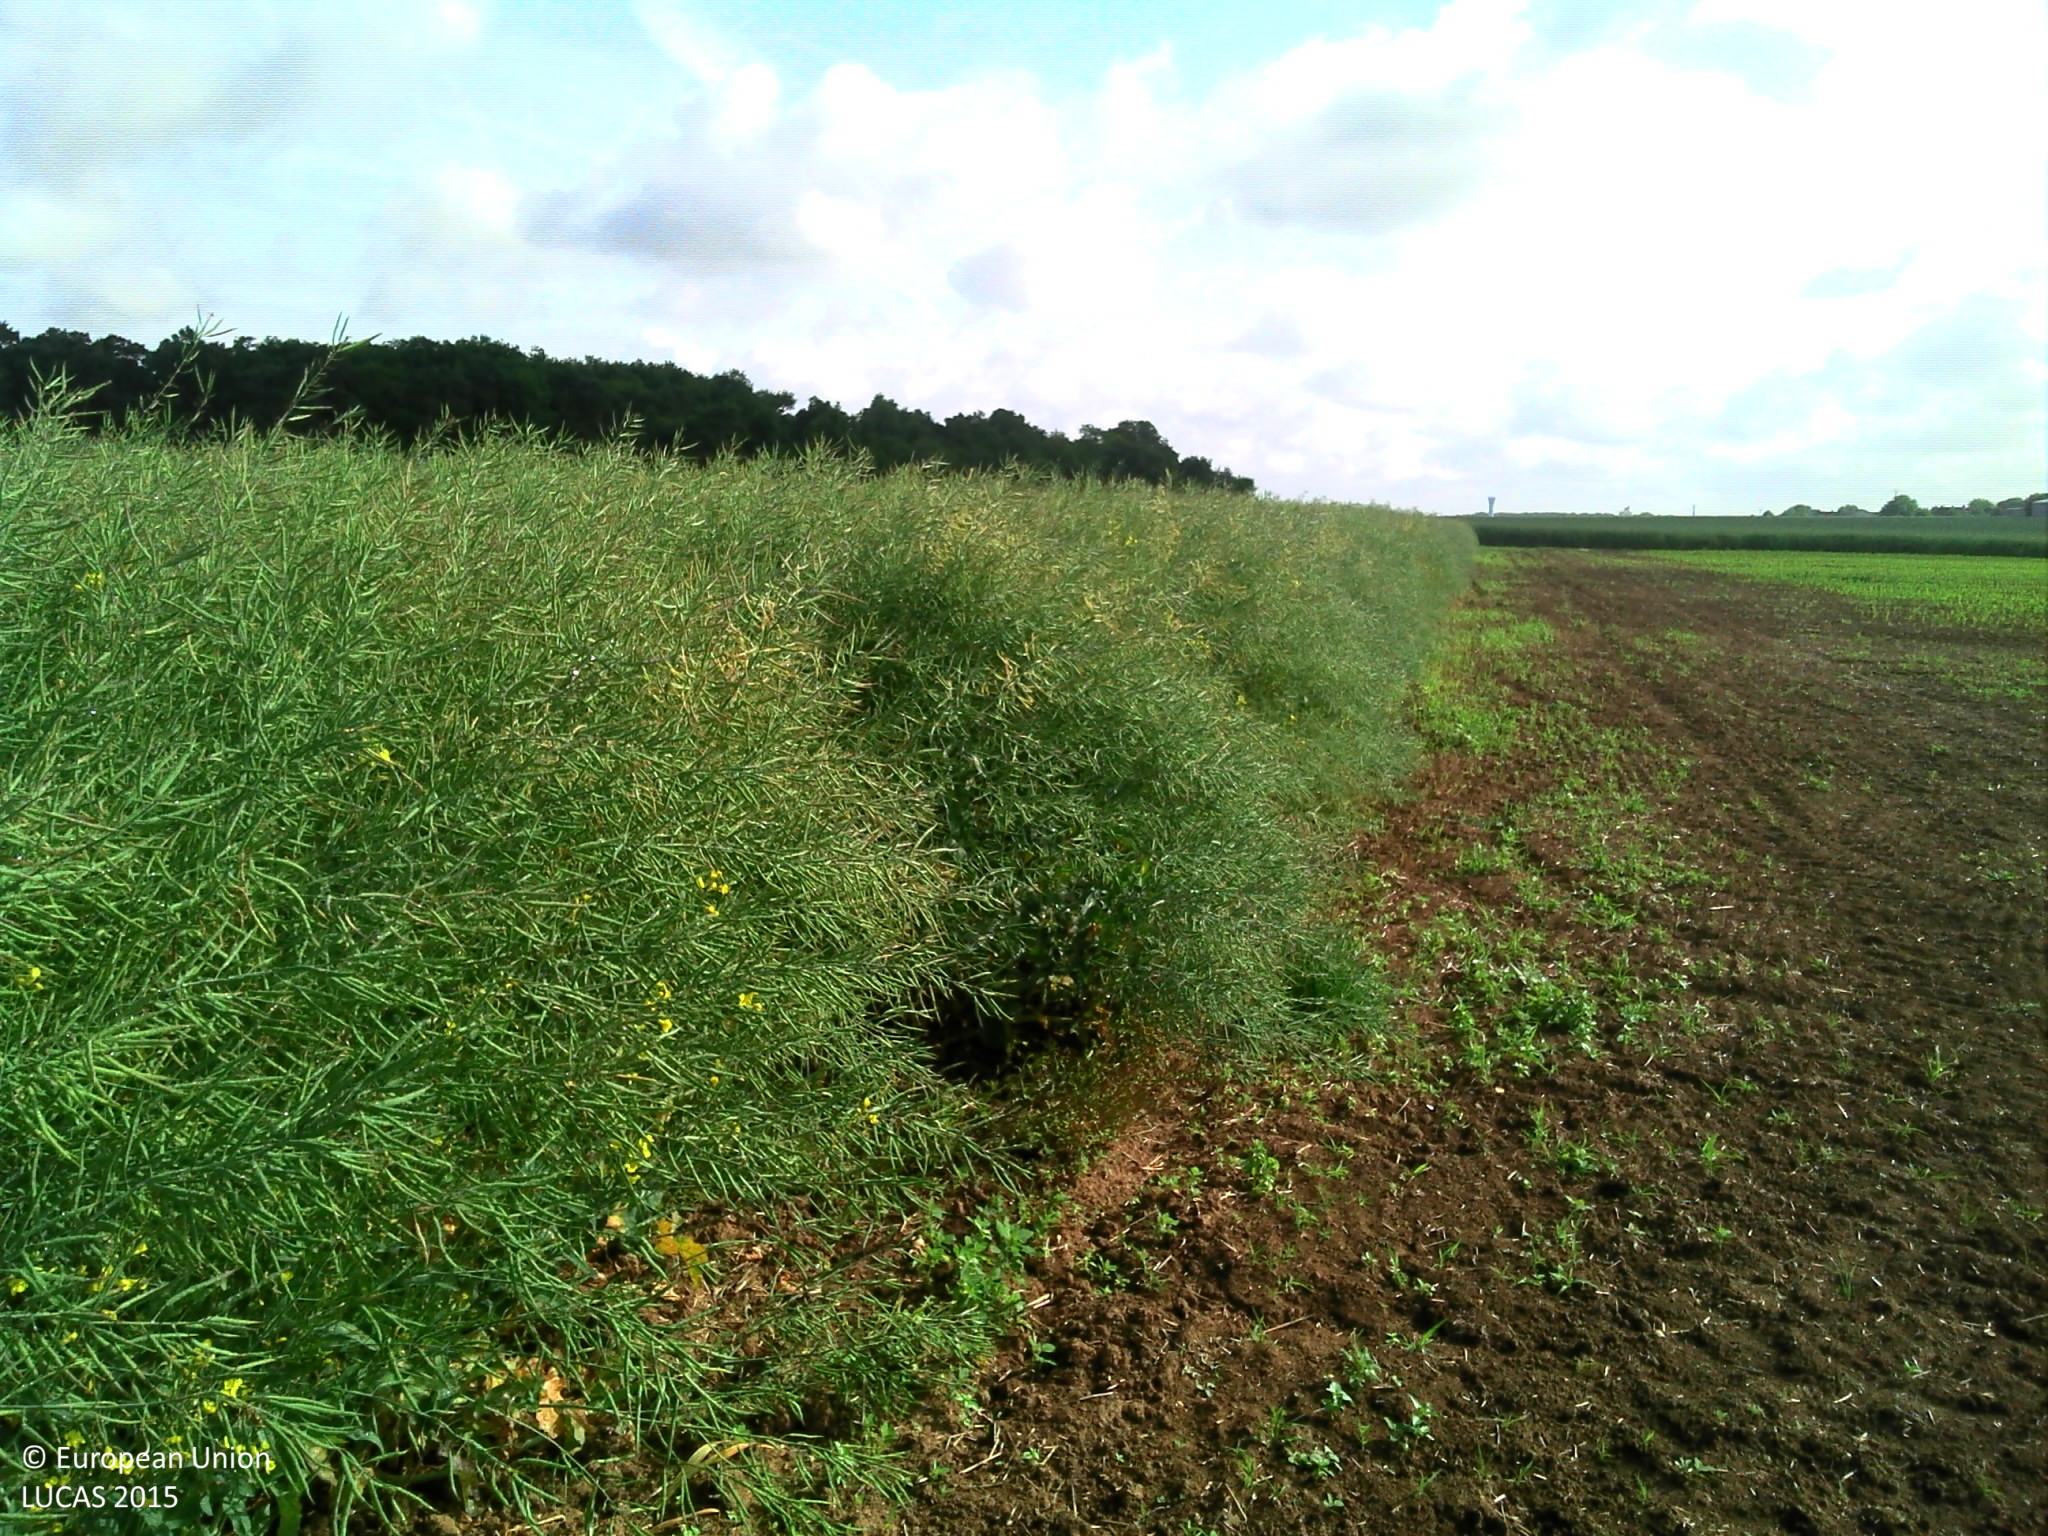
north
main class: Cropland
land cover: Rape and turnip rape
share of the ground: > 75 %
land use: Agriculture (excluding fallow land and kitchen gardens)
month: June
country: FR
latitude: 47.2425
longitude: 1.0400
